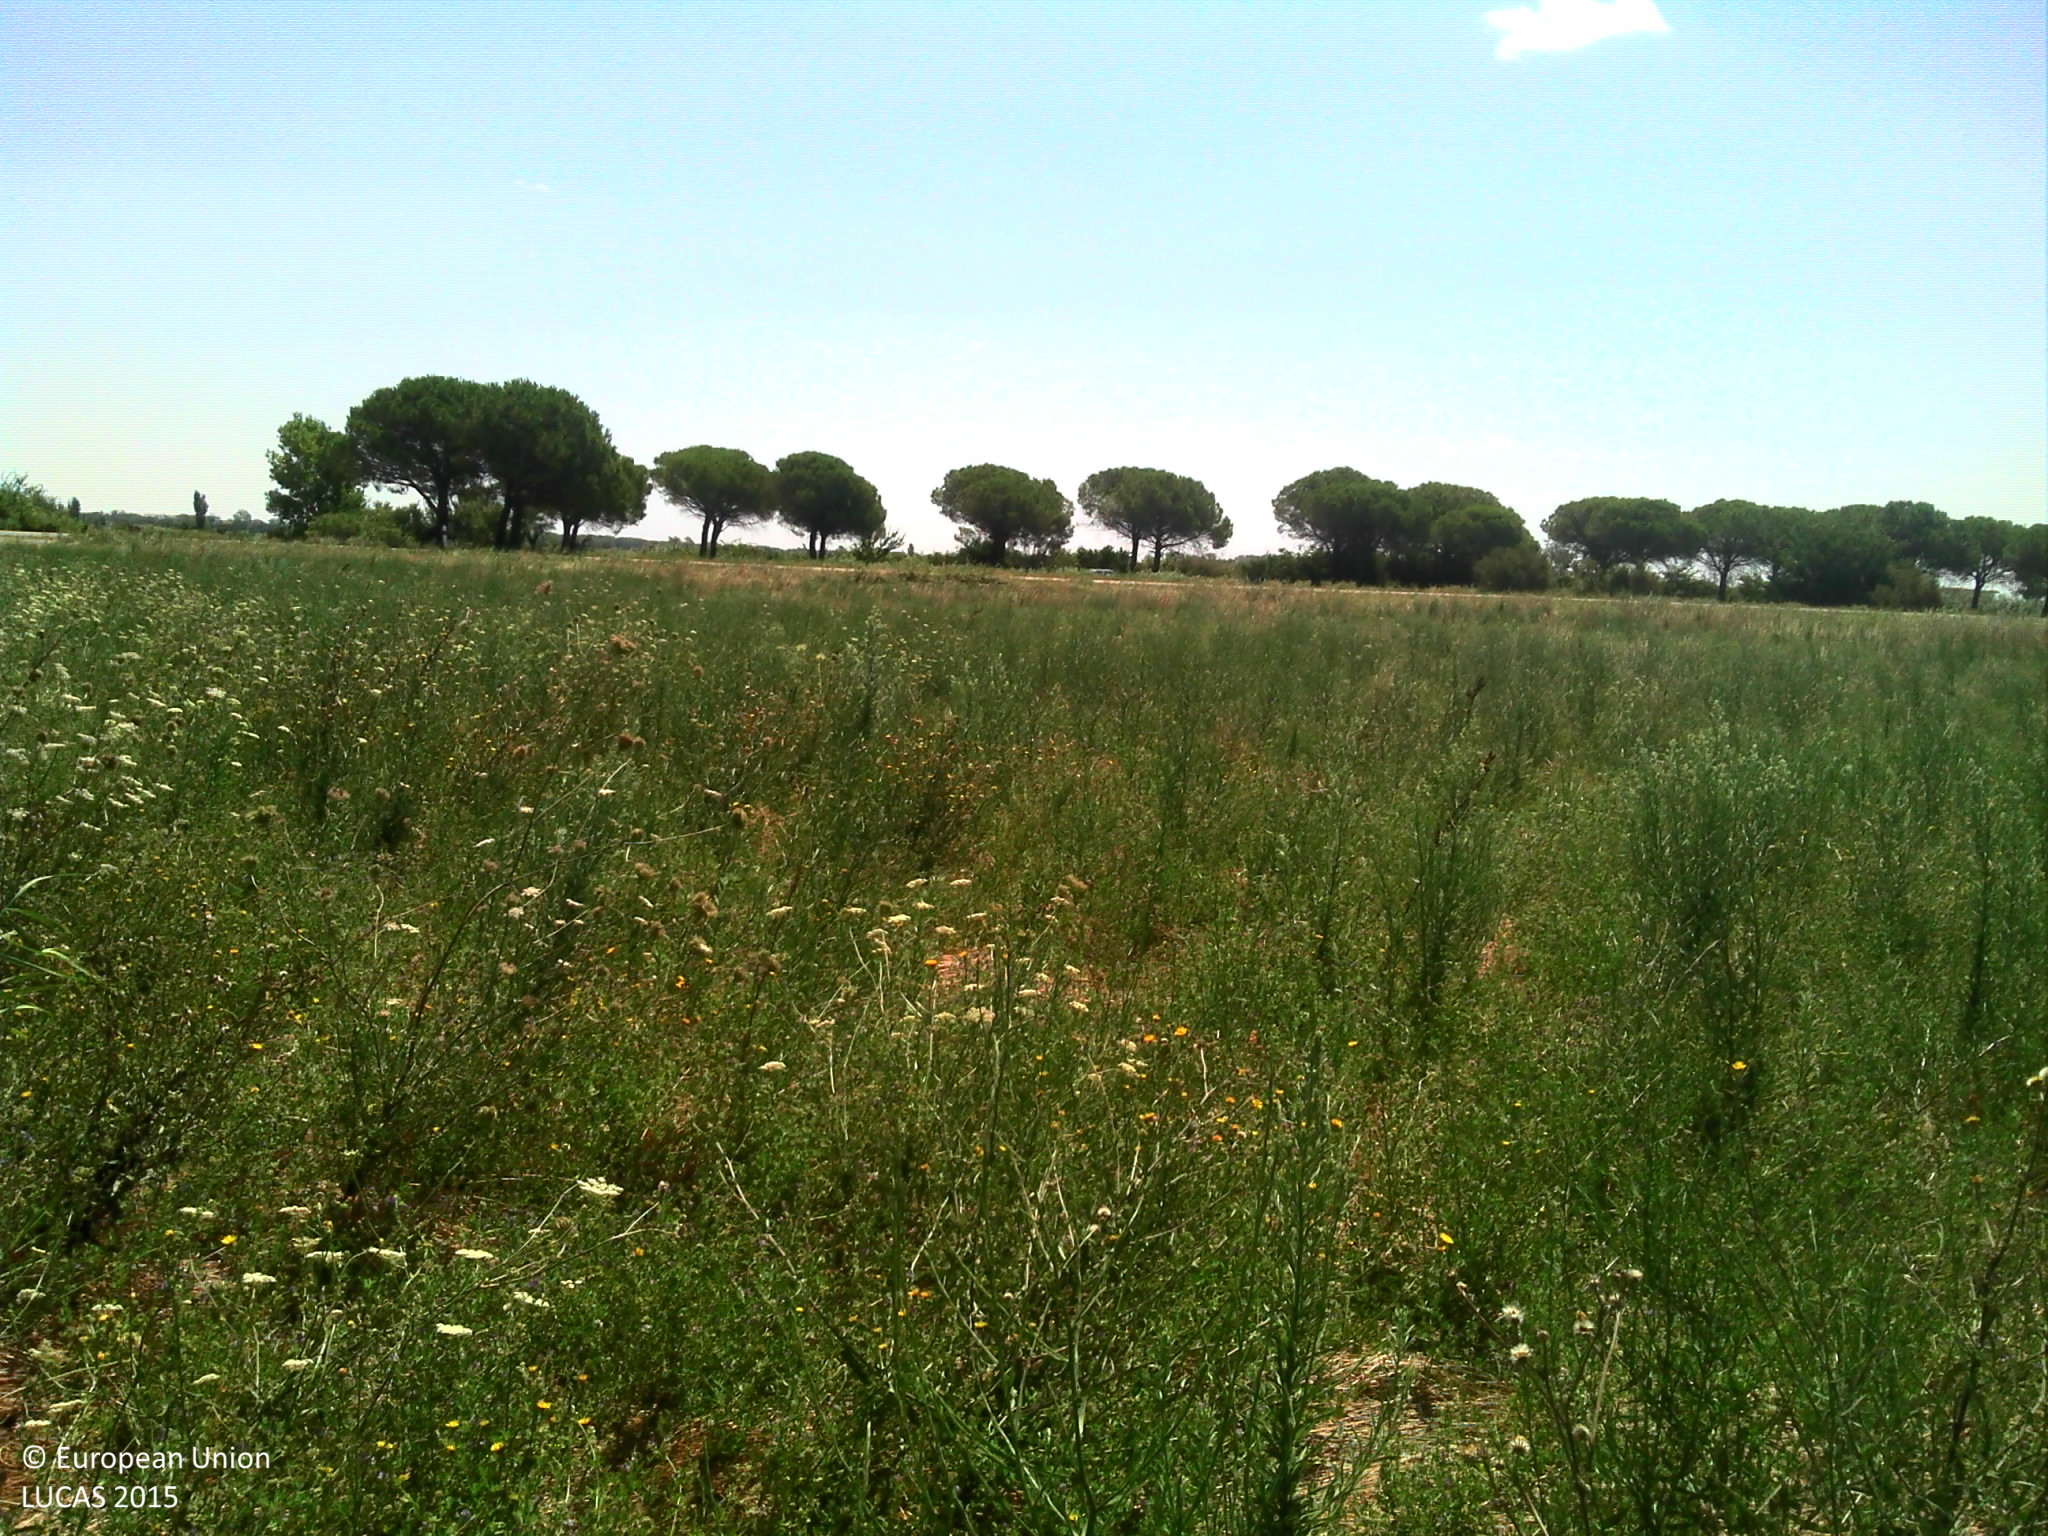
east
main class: Grassland
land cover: Grassland without tree/shrub cover
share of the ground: > 75 %
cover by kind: herbaceous plants 100 %
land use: Agriculture (excluding fallow land and kitchen gardens)
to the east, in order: Grassland without tree/shrub cover; Tracks; Grass margins; Ditches and canals; Grassland without tree/shrub cover; Grass margins; Paved roads, cycling and walking lanes; Other bare soil; Grass margins; Paved roads, cycling and walking lanes; Grass margins; Rivers and streams; Abandoned hedges; Tracks; Grass margins; Sunflower; Other fresh vegetables; Spontaneously vegetated surfaces
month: July
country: FR
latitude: 43.4743
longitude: 4.7067
